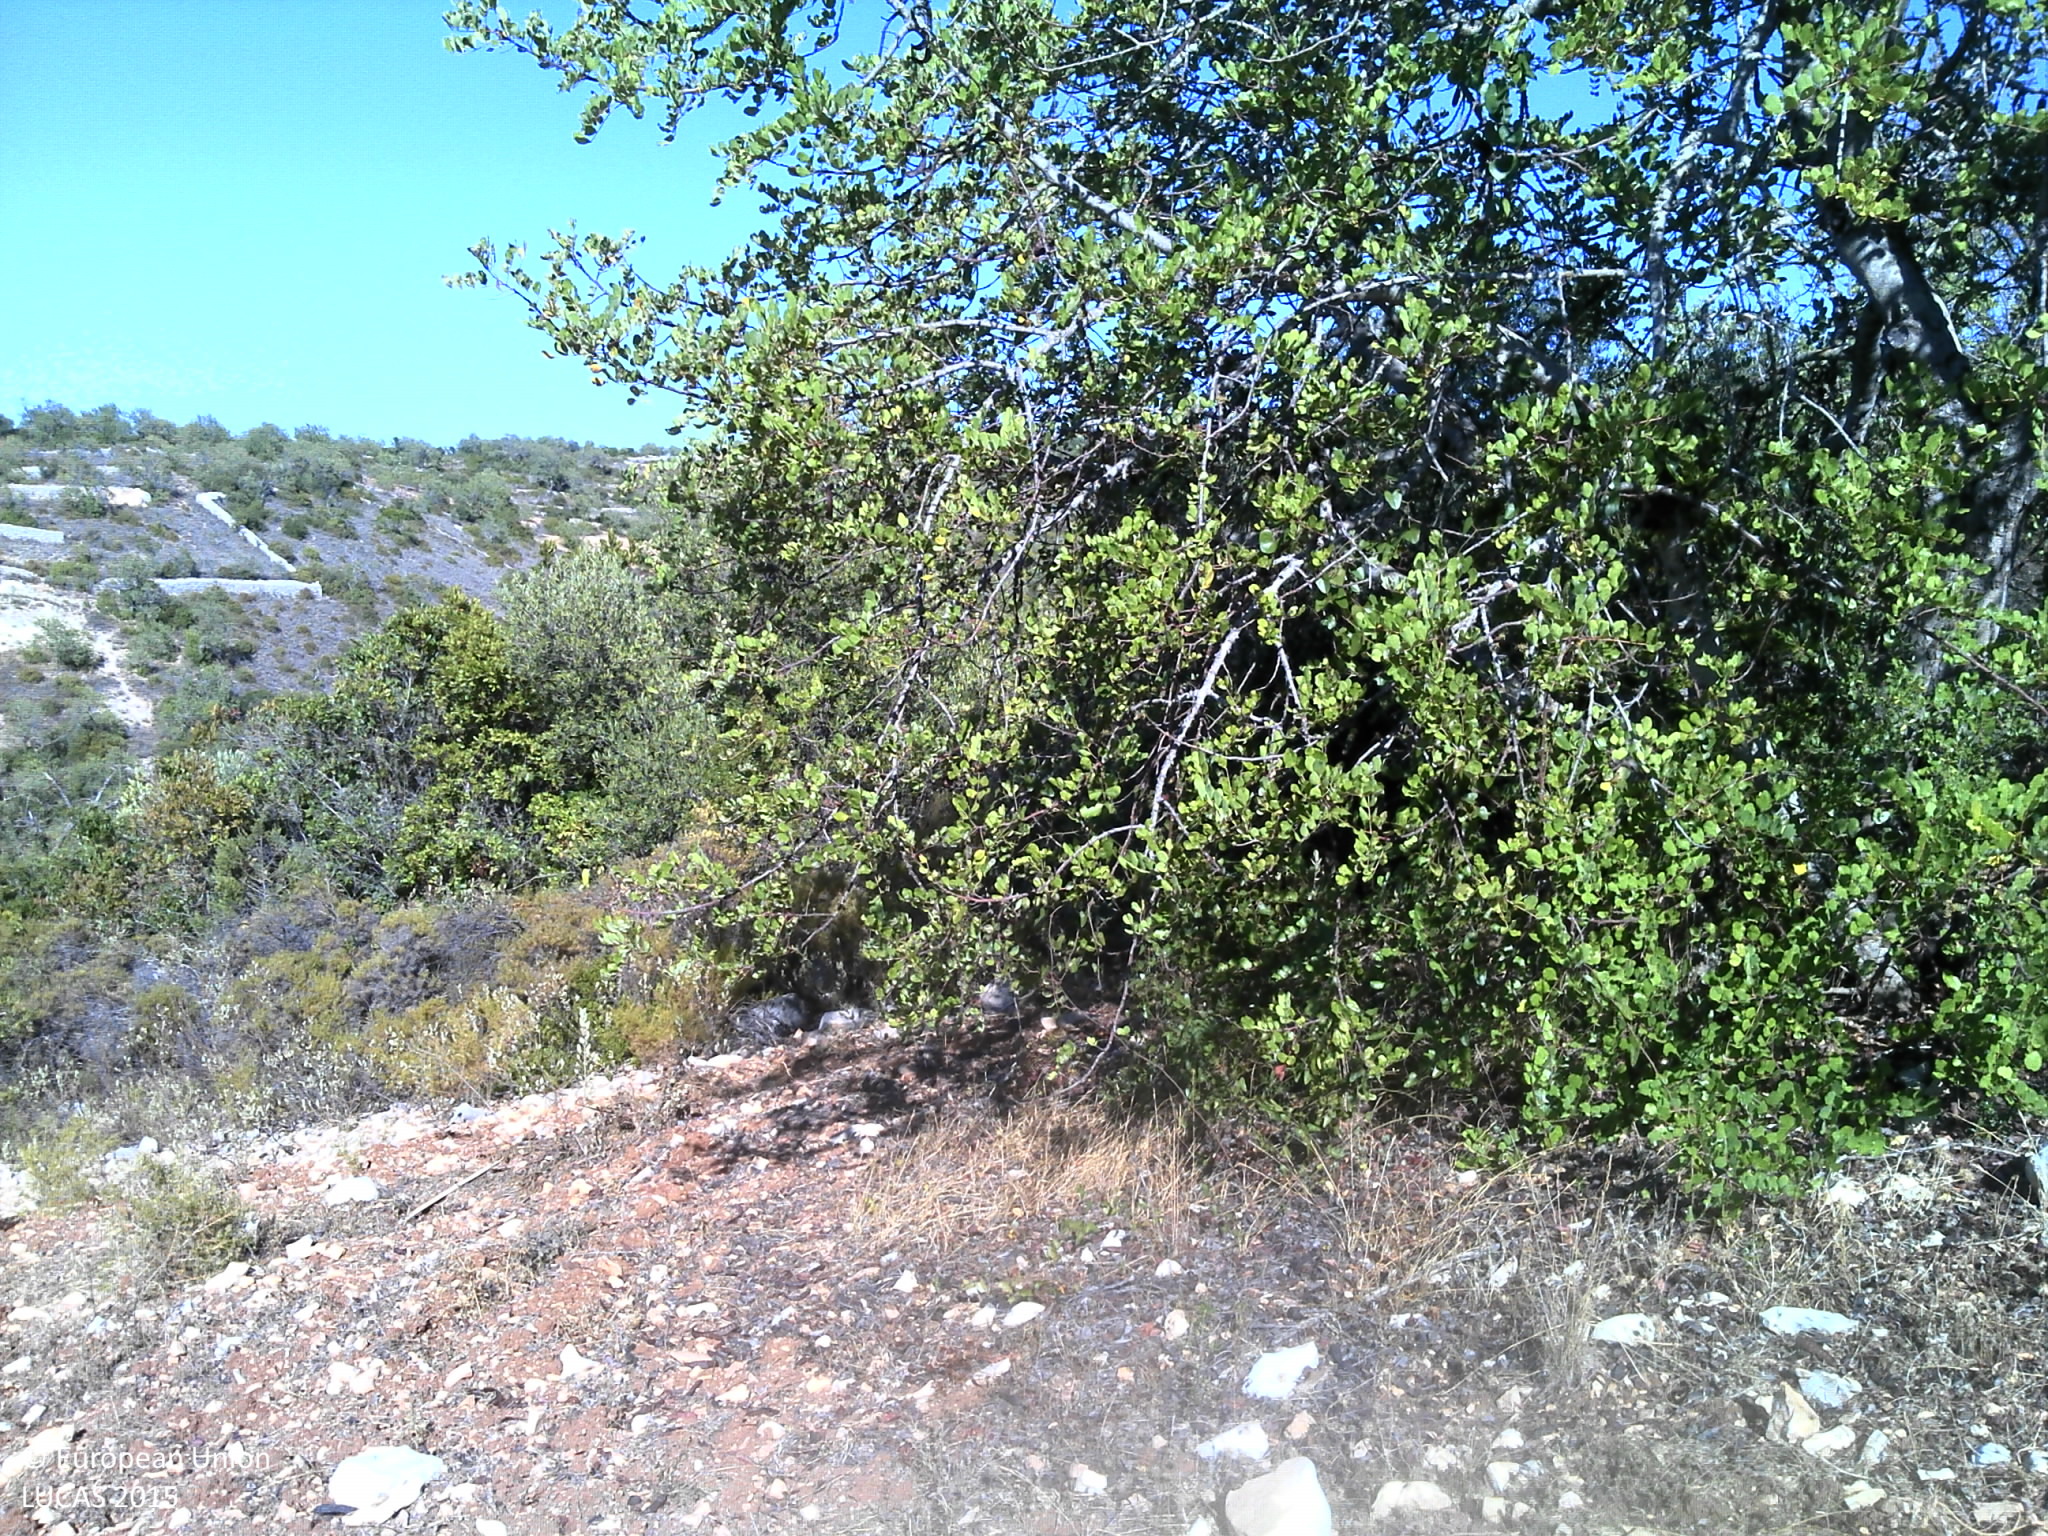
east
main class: Cropland
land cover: Permanent industrial crops
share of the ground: 25 - 50 %
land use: Agriculture (excluding fallow land and kitchen gardens)
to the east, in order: Permanent industrial crops; Dry stone walls; Shrubland with sparse tree cover; Dry stone walls; Shrubland with sparse tree cover; Rivers and streams; Shrubland with sparse tree cover; Dry stone walls; Shrubland with sparse tree cover; Dry stone walls; Shrubland with sparse tree cover; Dry stone walls; Shrubland with sparse tree cover; Dry stone walls; Shrubland with sparse tree cover; Dry stone walls; Shrubland with sparse tree cover; Dry stone walls; Permanent industrial crops; Tracks; Shrubland with sparse tree cover
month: September
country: PT
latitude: 37.1771
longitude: -8.1162
